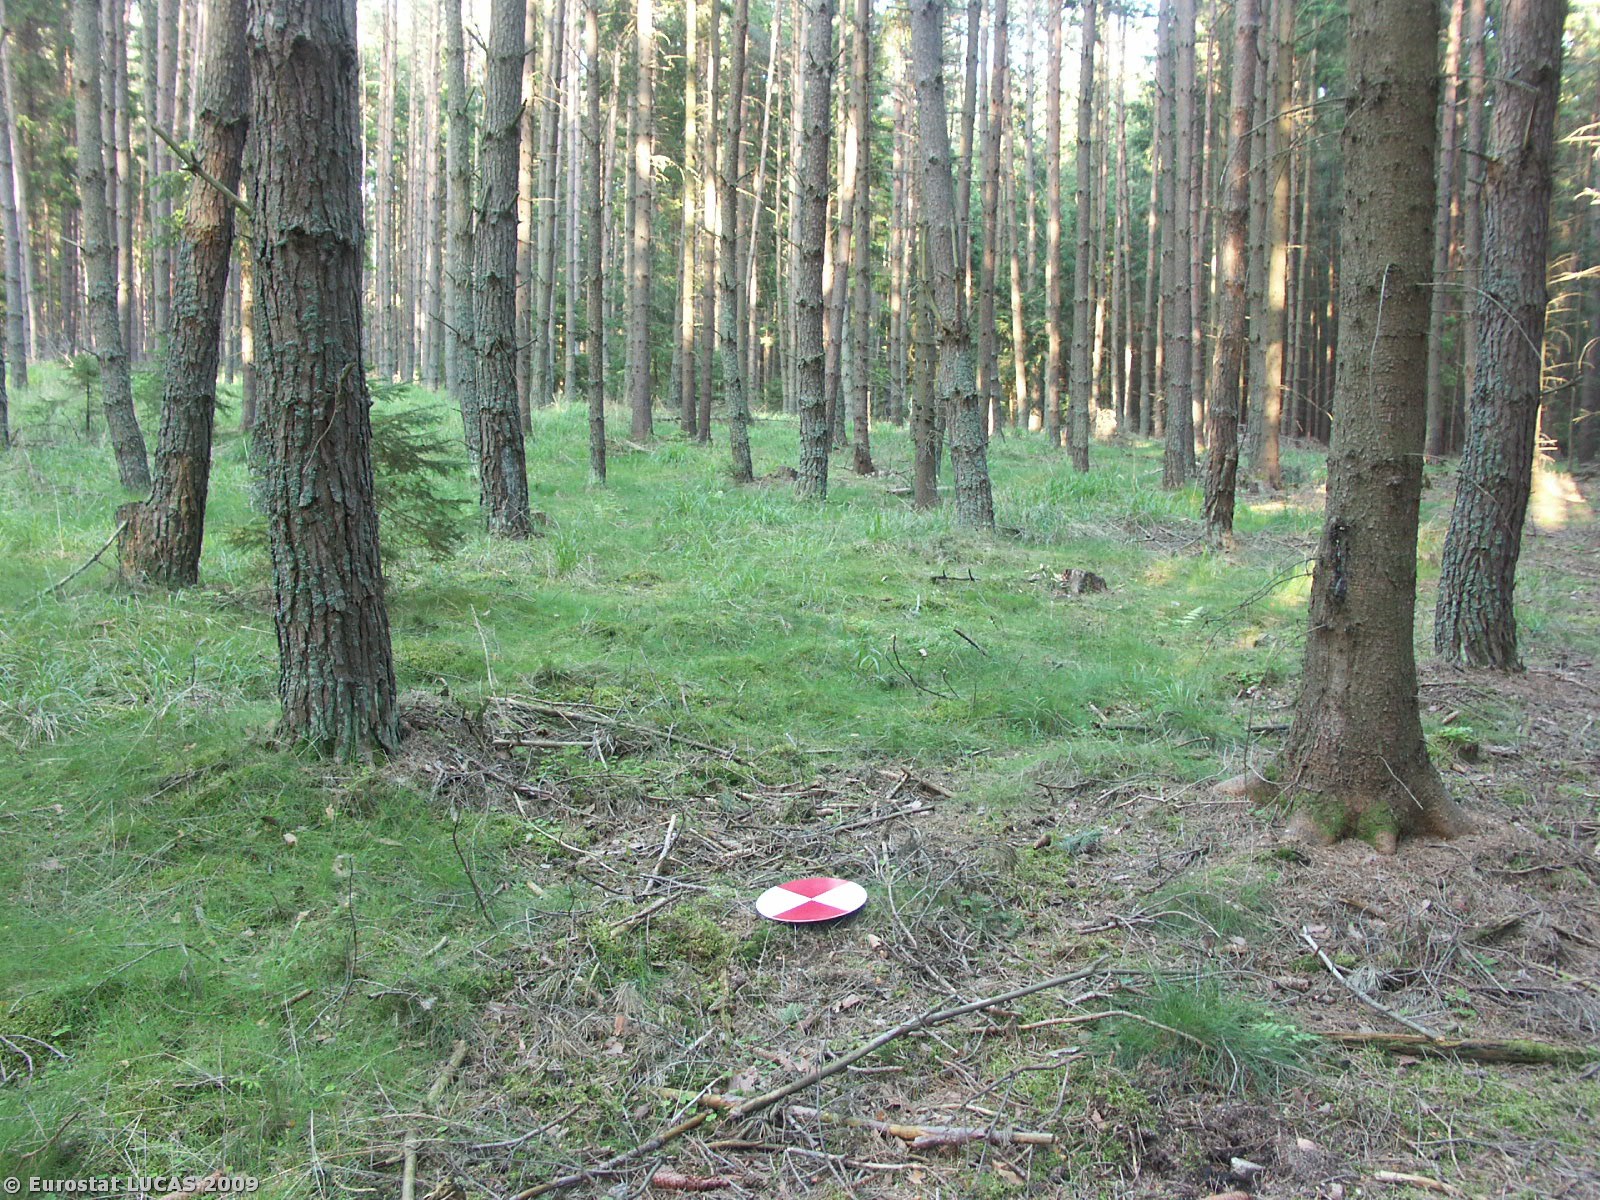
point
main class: Woodland
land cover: Coniferous woodland
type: hemiboreal forest and nemoral coniferous forest and mixed broadleaved-coniferous forest
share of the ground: > 75 %
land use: Forestry
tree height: > 5 m
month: May
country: CZ
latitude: 49.0492
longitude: 15.3528
